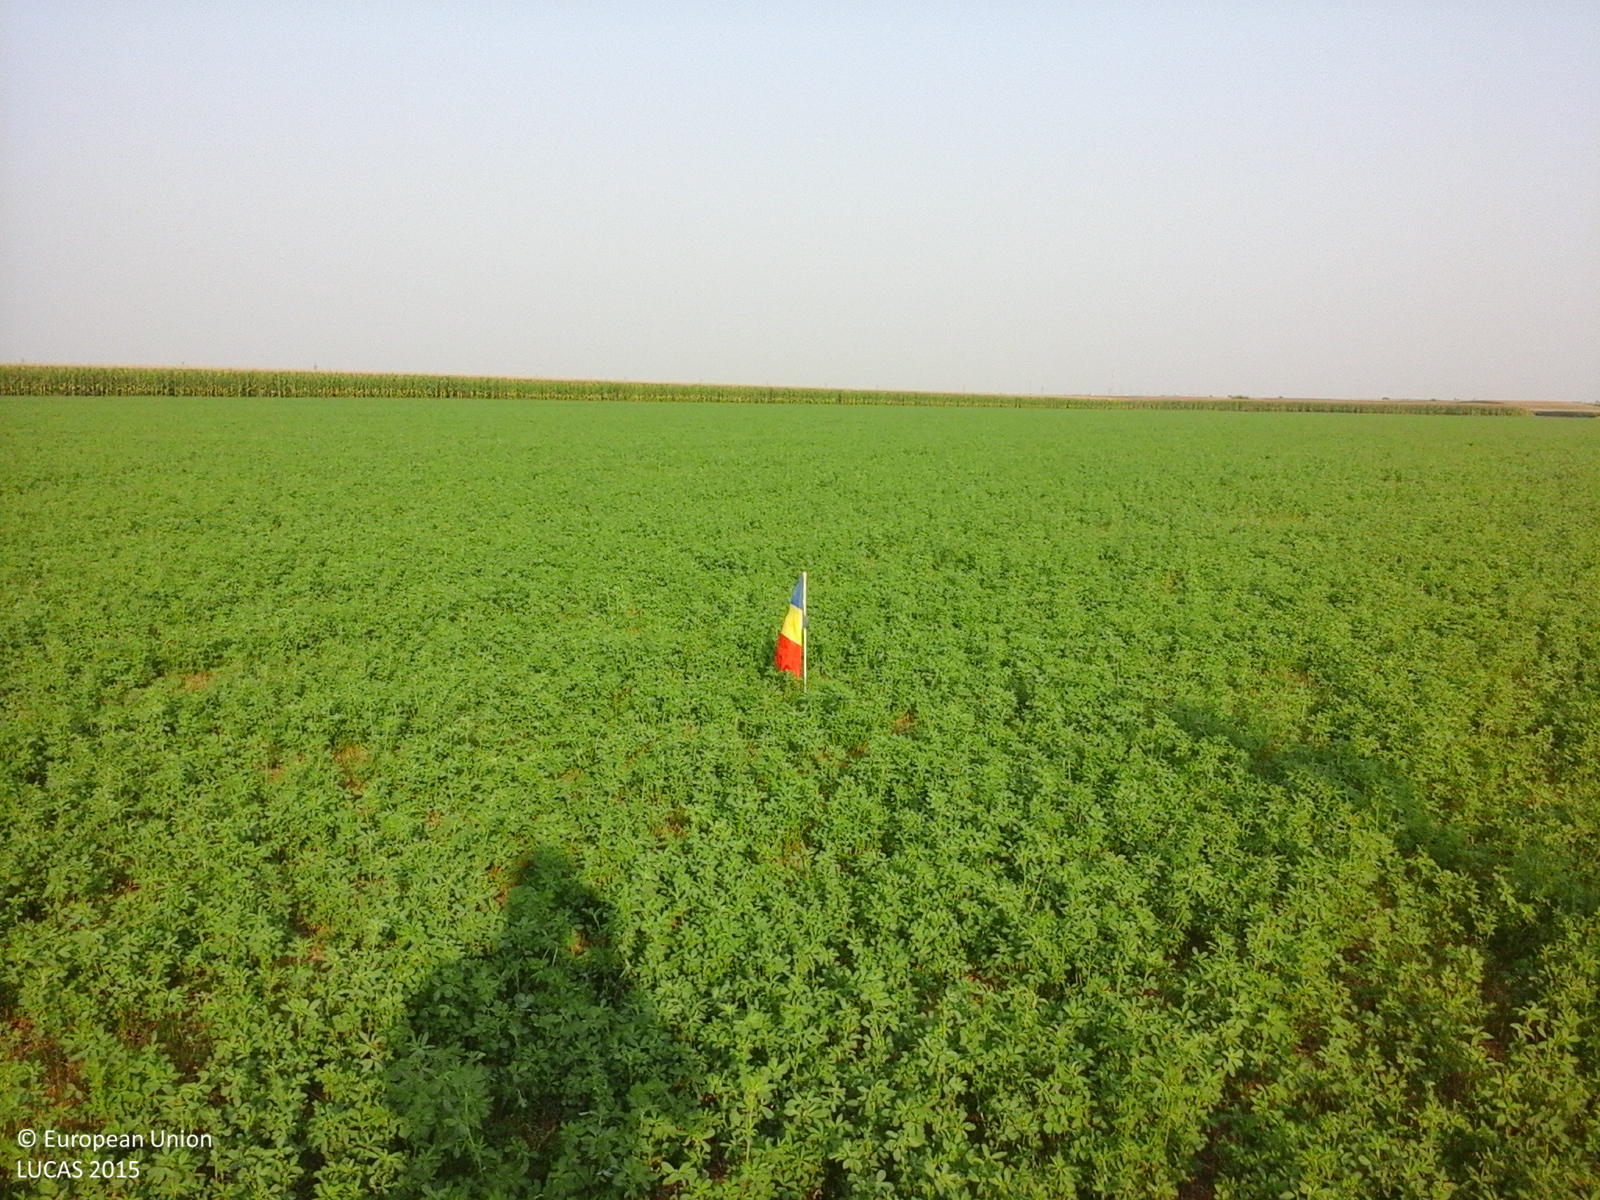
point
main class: Cropland
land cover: Lucerne
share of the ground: > 75 %
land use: Agriculture (excluding fallow land and kitchen gardens)
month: July
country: RO
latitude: 44.5024
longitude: 26.5301
